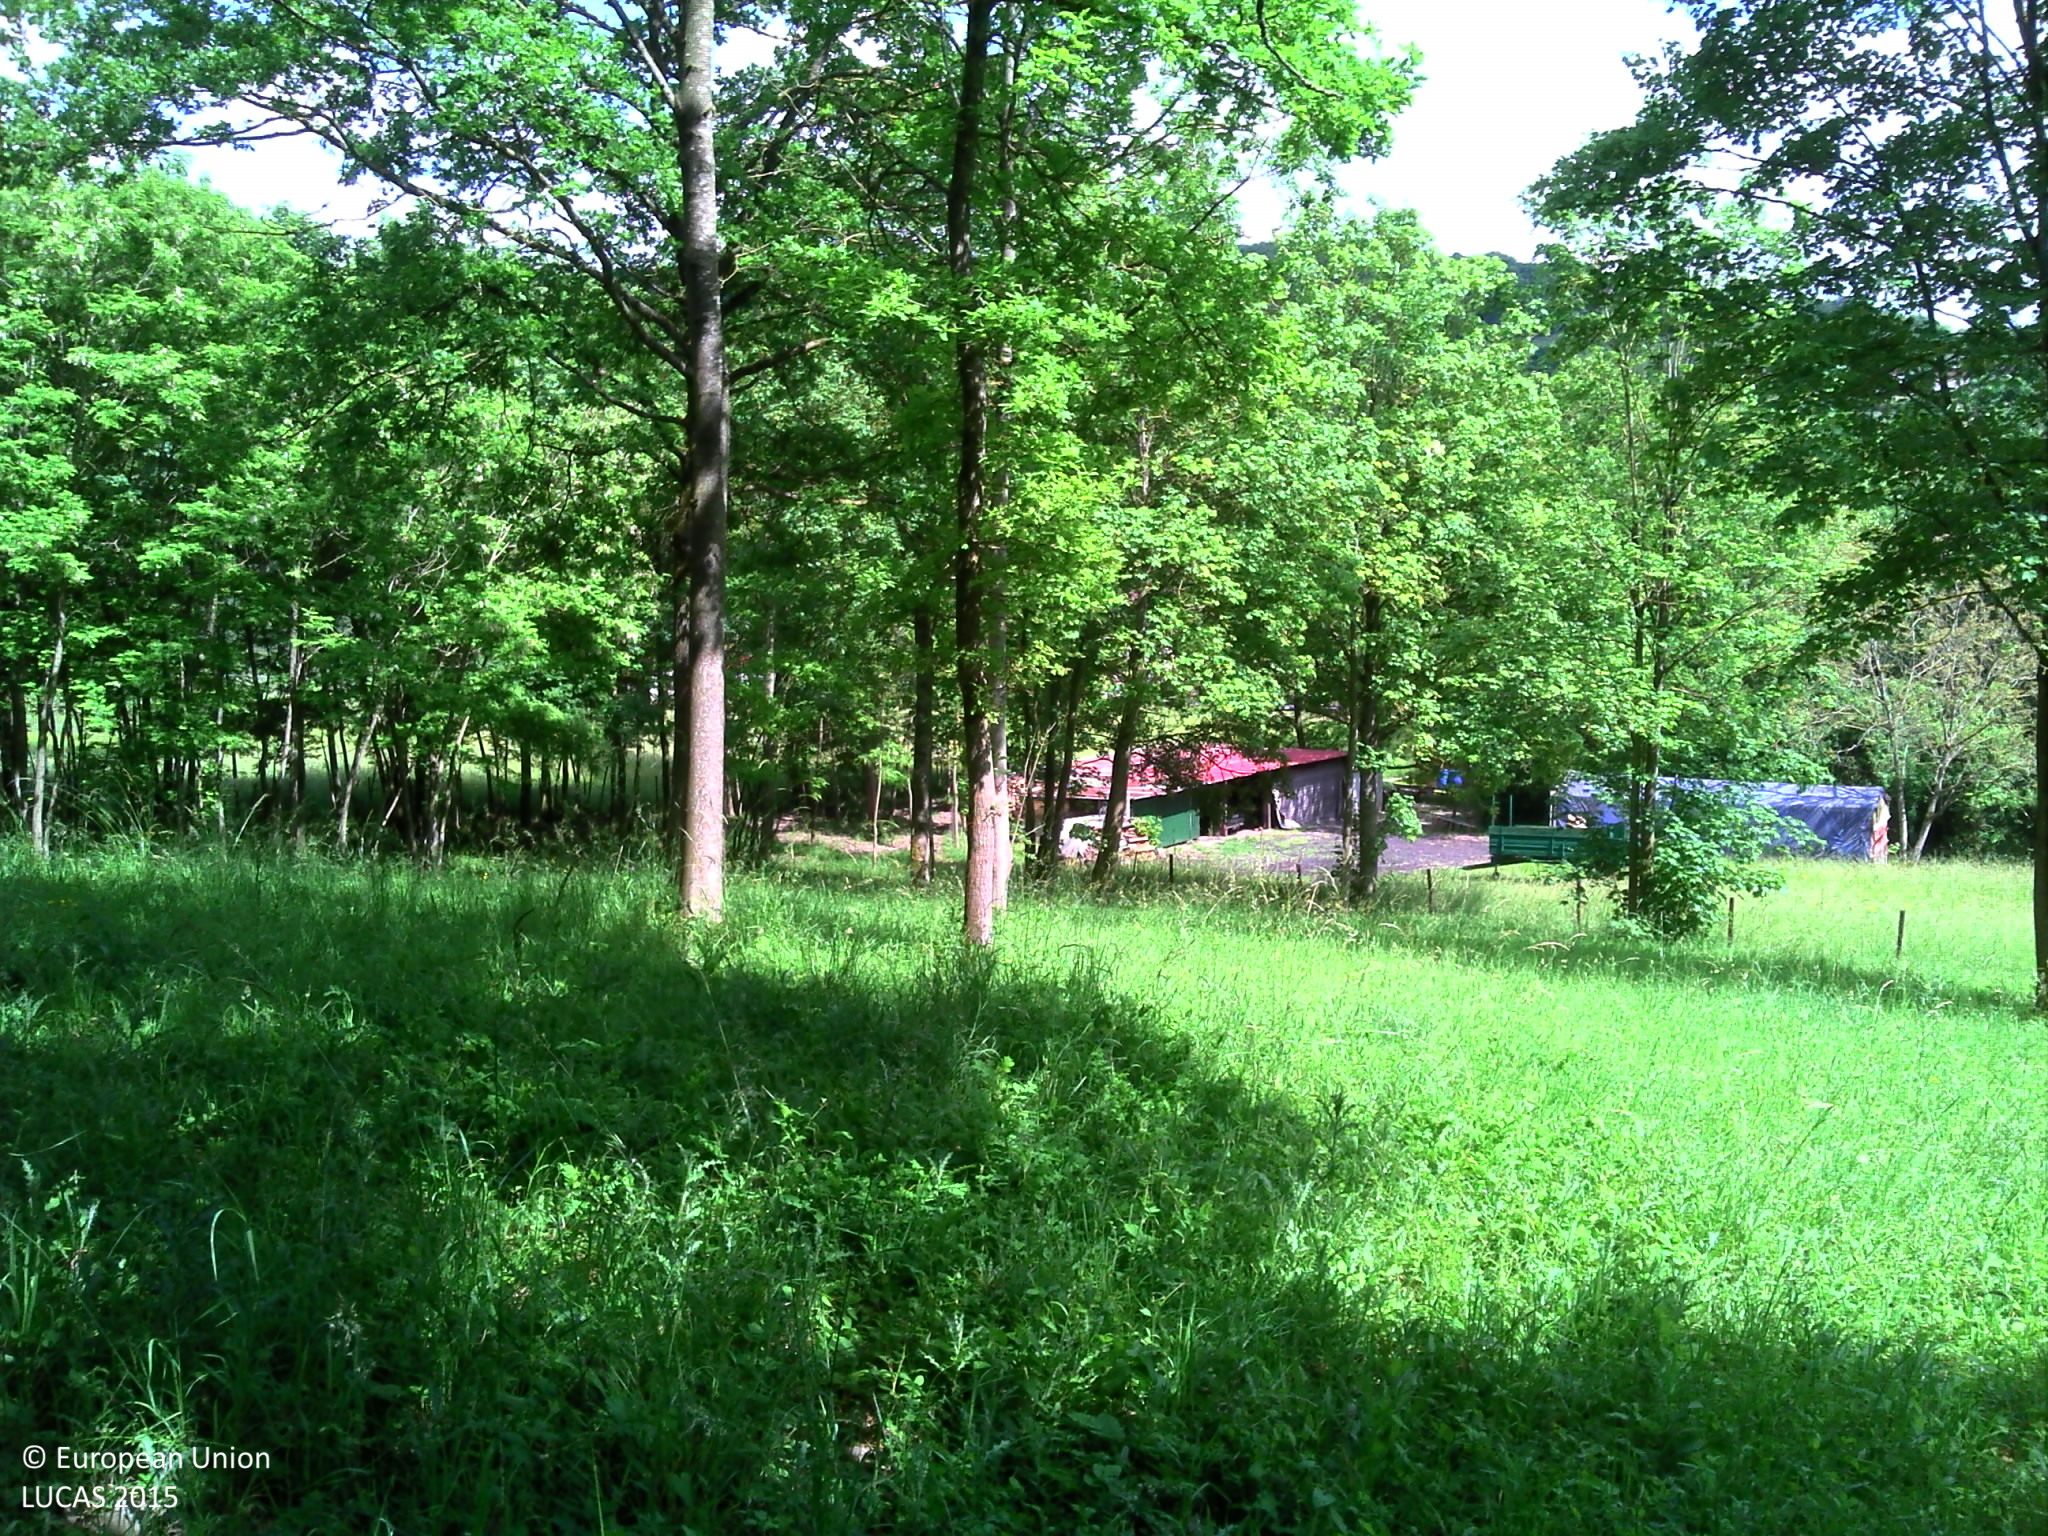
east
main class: Woodland
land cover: Broadleaved woodland
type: mesophytic deciduous forest
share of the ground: > 75 %
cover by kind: broadleaved forest trees 50 %, herbaceous plants 50 %
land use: Agriculture (excluding fallow land and kitchen gardens)
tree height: > 5 m
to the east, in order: Broadleaved woodland; Fences; Grass margins; Fences; Grassland without tree/shrub cover; Fences; Grassland without tree/shrub cover; Artificial constructions in urban areas; Shruby margins; Fences; Grassland without tree/shrub cover
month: June
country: FR
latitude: 48.6476
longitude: 6.2947
